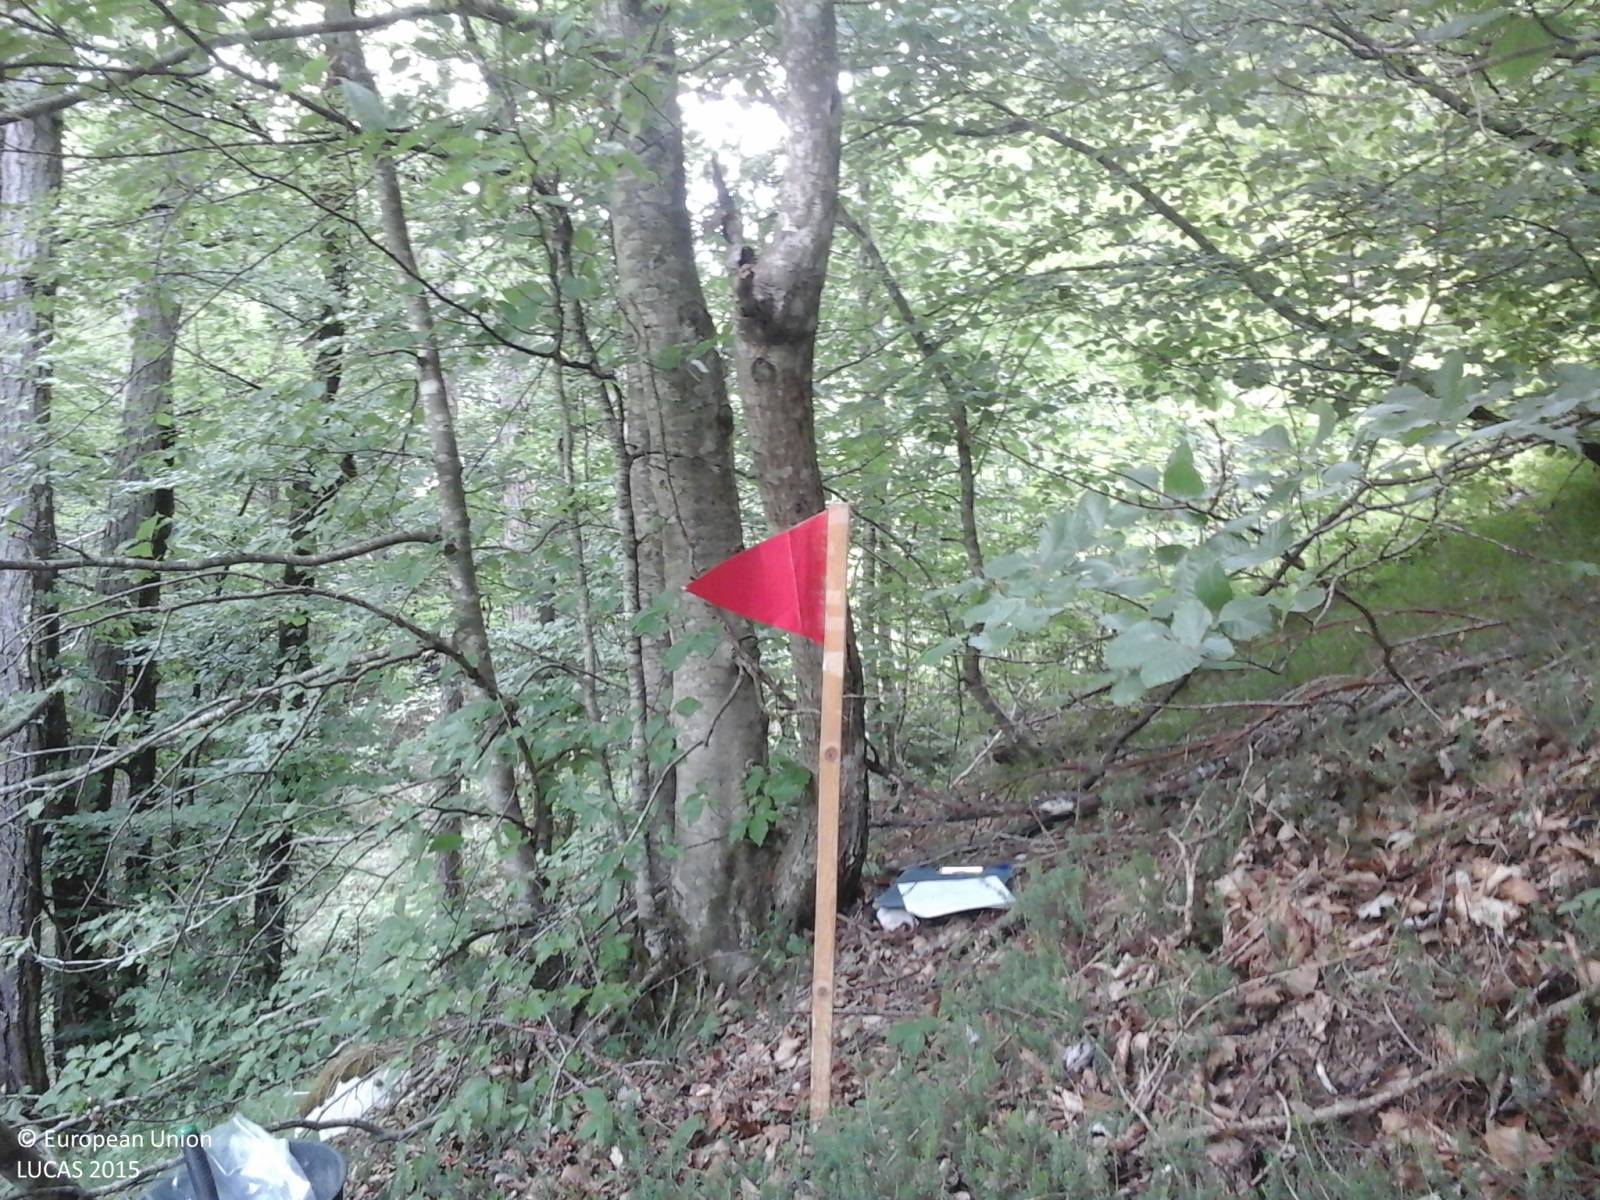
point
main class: Woodland
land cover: Broadleaved woodland
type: mountainous beech forest
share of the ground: > 75 %
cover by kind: broadleaved forest trees 75 %, coniferous forest trees 25 %
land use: Forestry
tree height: > 5 m
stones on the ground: > 50 %
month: July
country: IT
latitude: 46.2877
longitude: 12.4244
